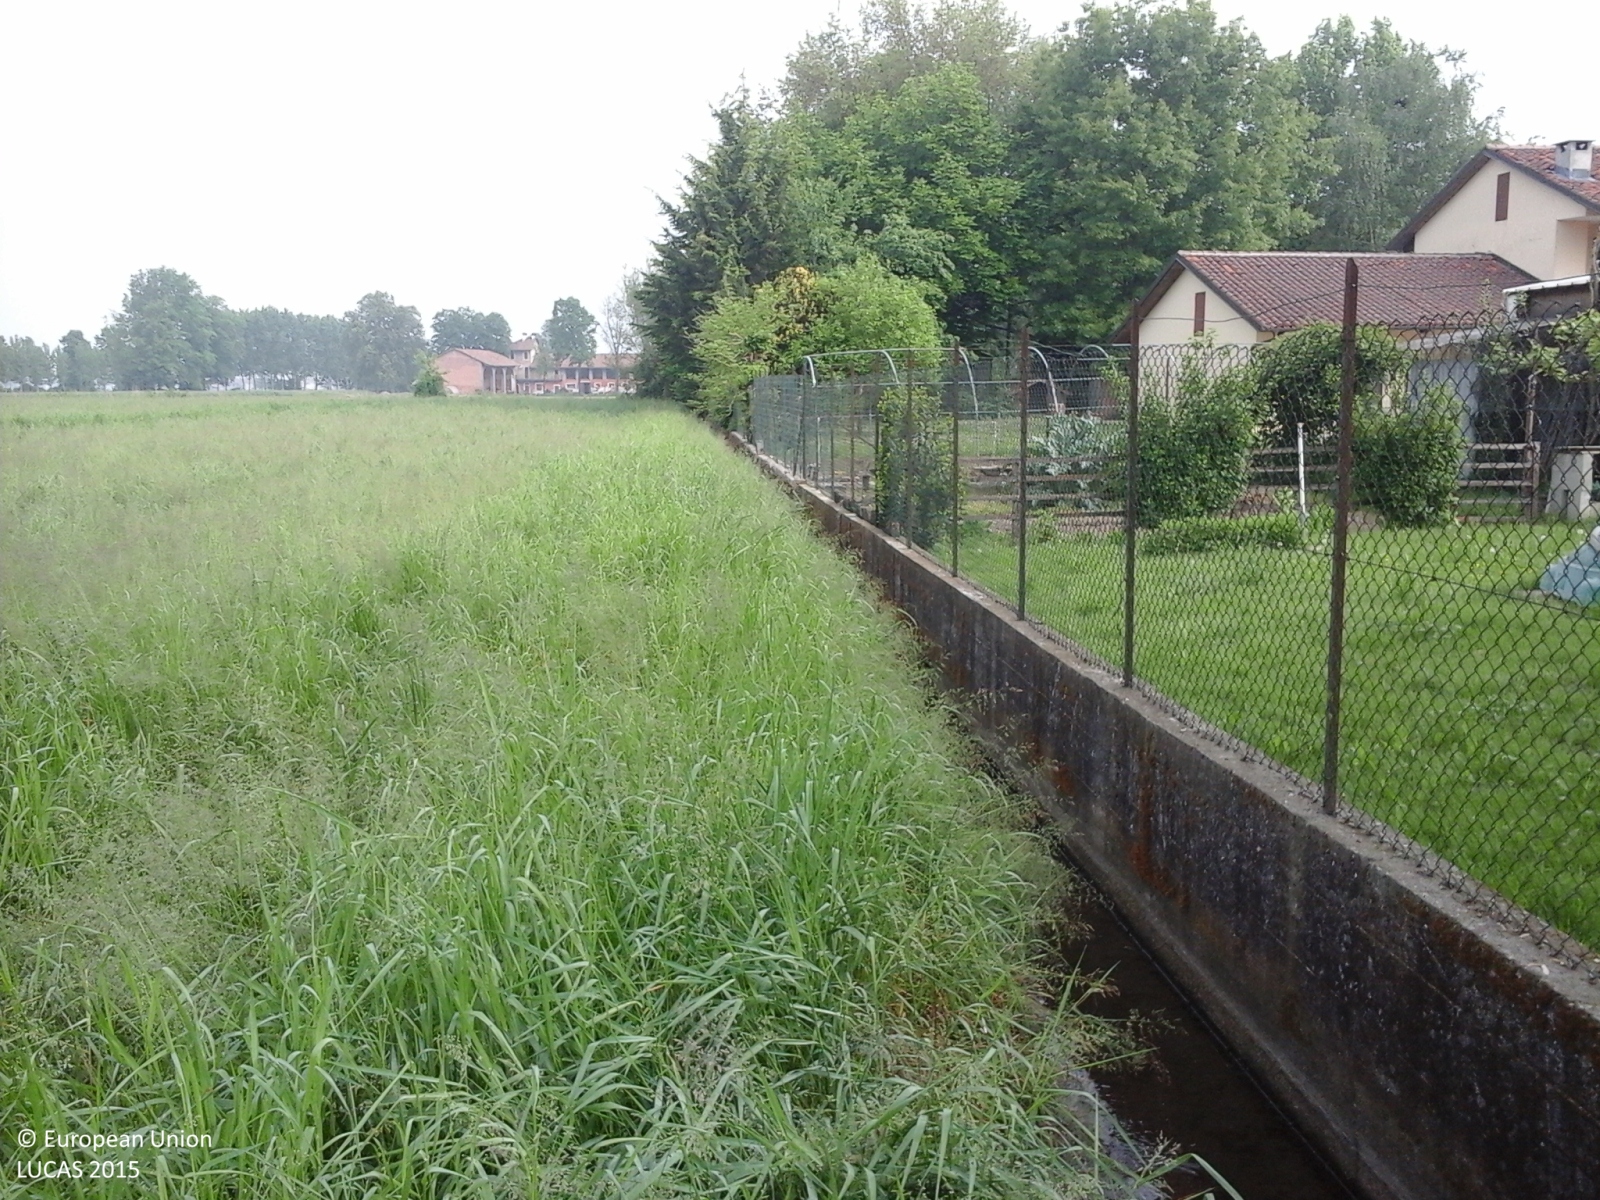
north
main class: Cropland
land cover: Temporary grasslands
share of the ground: > 75 %
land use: Agriculture (excluding fallow land and kitchen gardens)
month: May
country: IT
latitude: 44.6317
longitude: 7.6978
